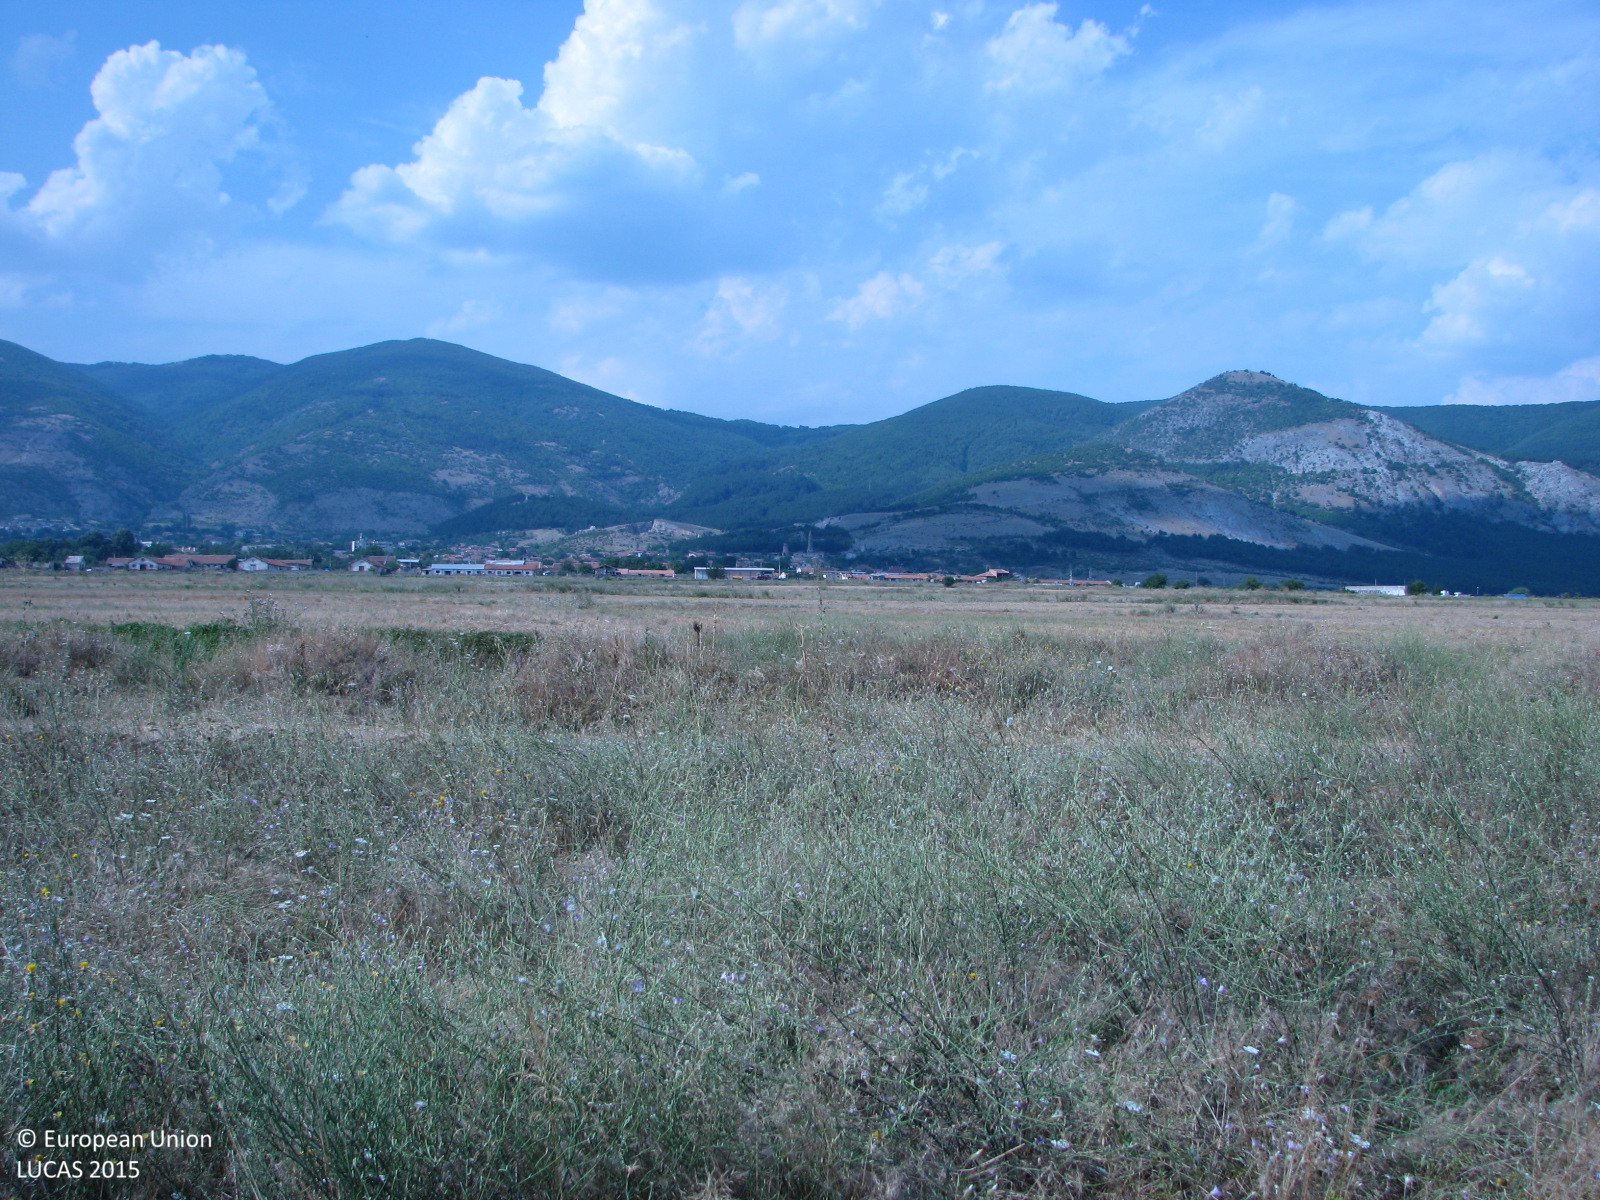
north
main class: Grassland
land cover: Grassland without tree/shrub cover
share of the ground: > 75 %
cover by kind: herbaceous plants 100 %
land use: Agriculture (excluding fallow land and kitchen gardens)
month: July
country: BG
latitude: 42.6719
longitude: 26.0317
